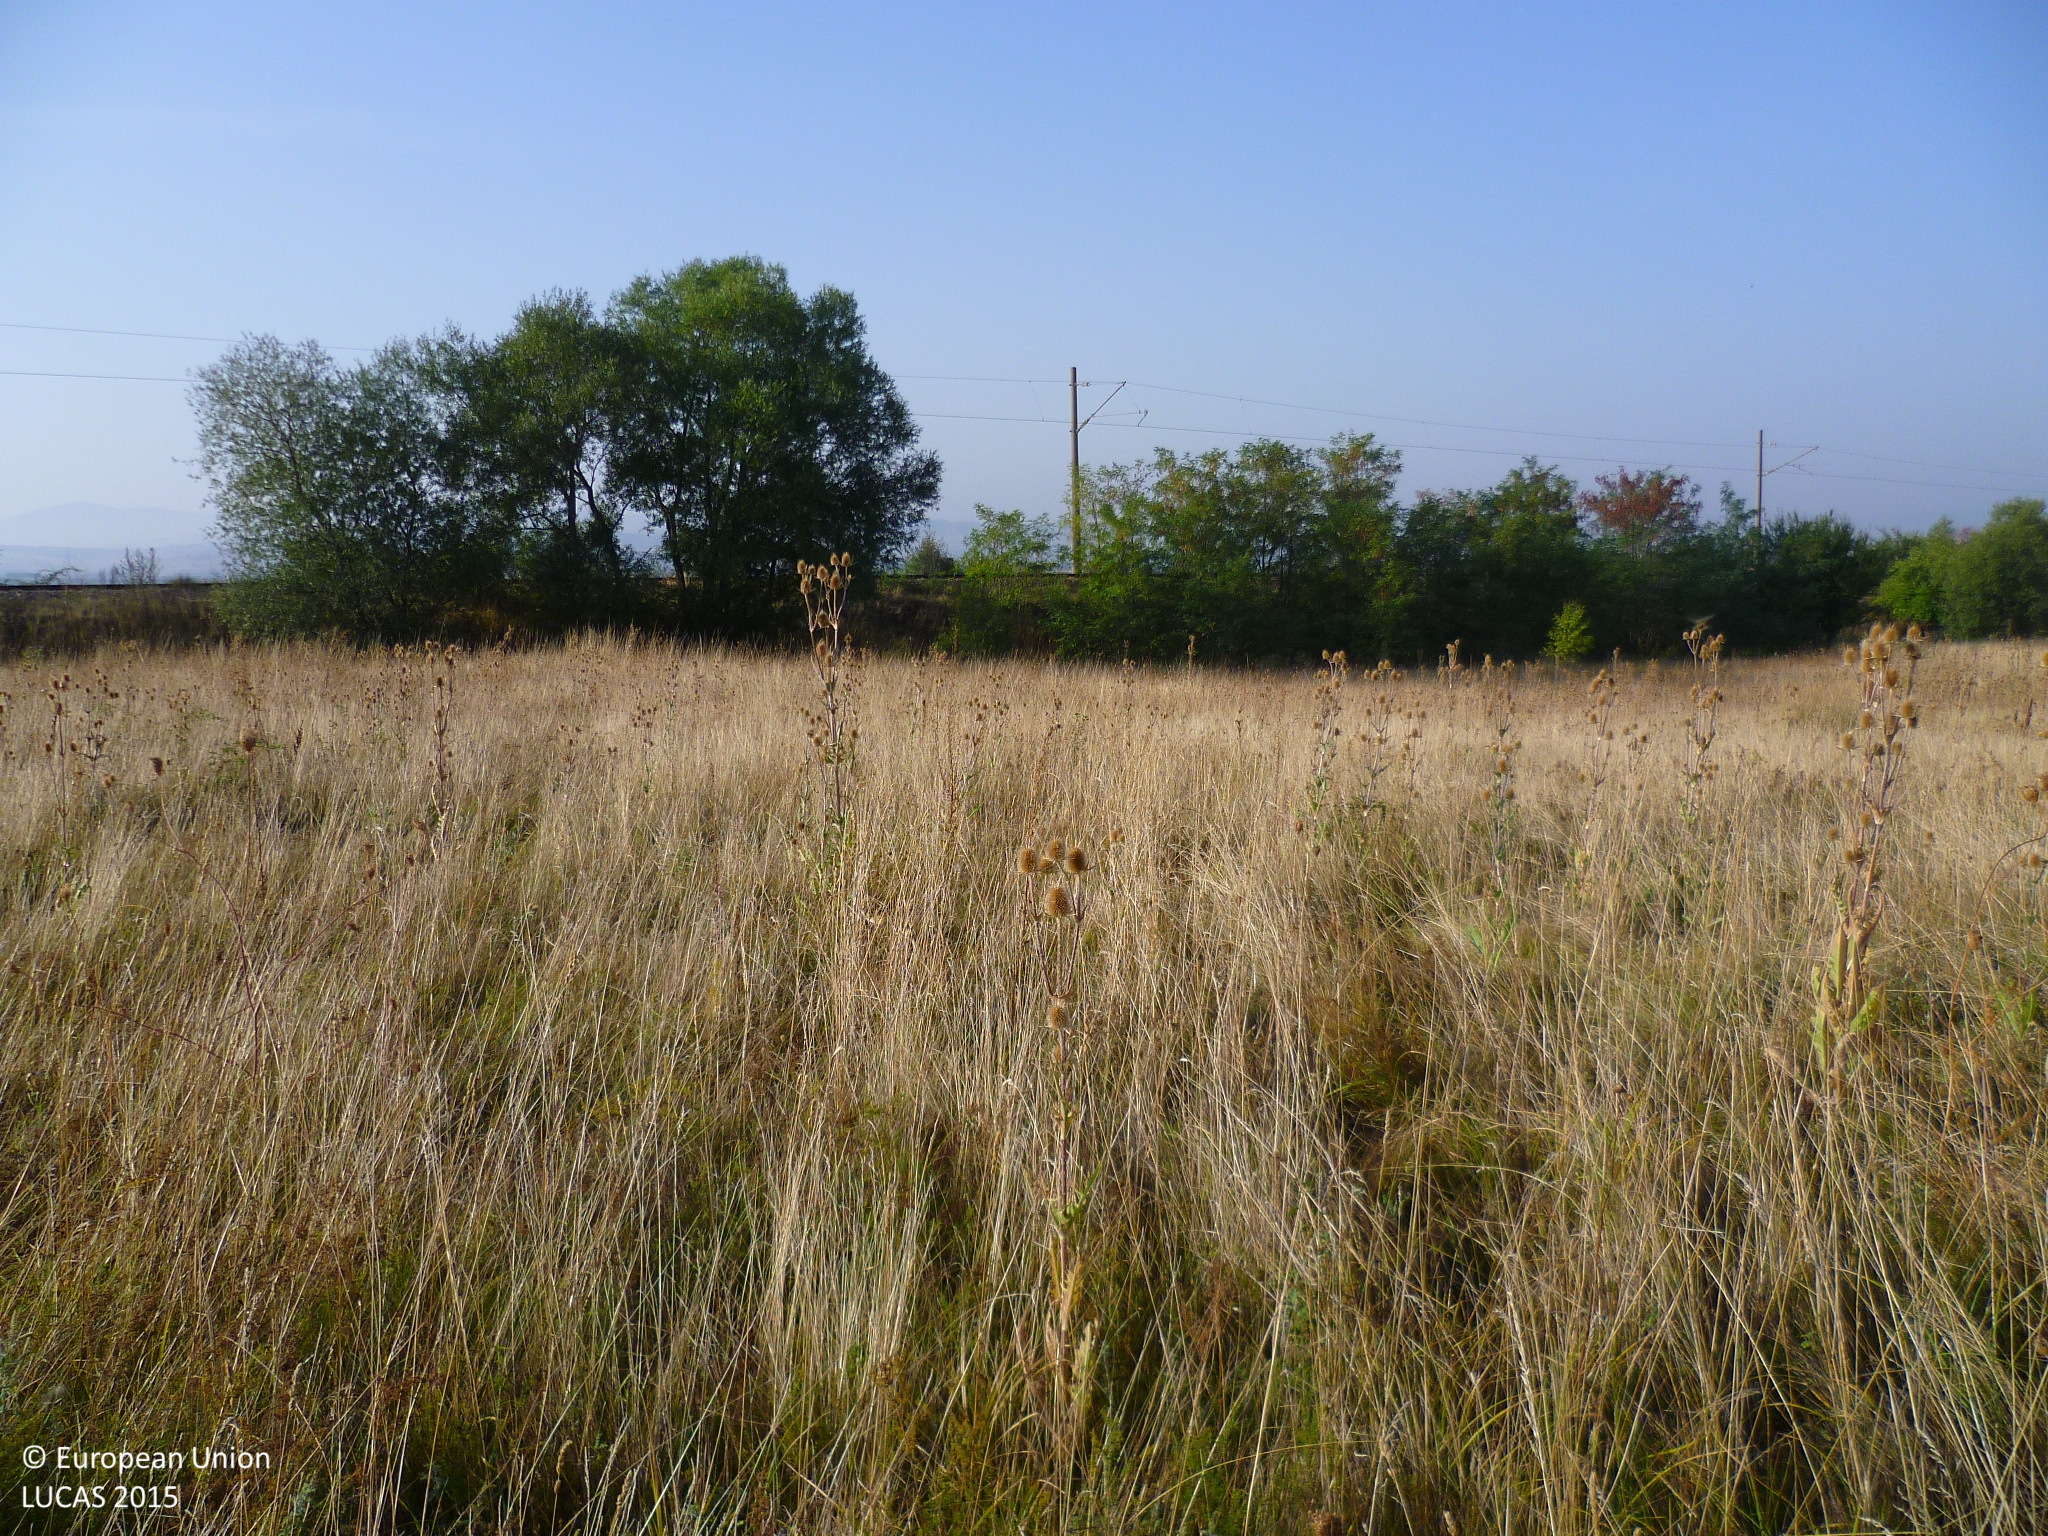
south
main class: Grassland
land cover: Grassland without tree/shrub cover
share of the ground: > 75 %
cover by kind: herbaceous plants 100 %
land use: Agriculture (excluding fallow land and kitchen gardens)
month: September
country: BG
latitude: 42.6885
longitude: 23.0039
